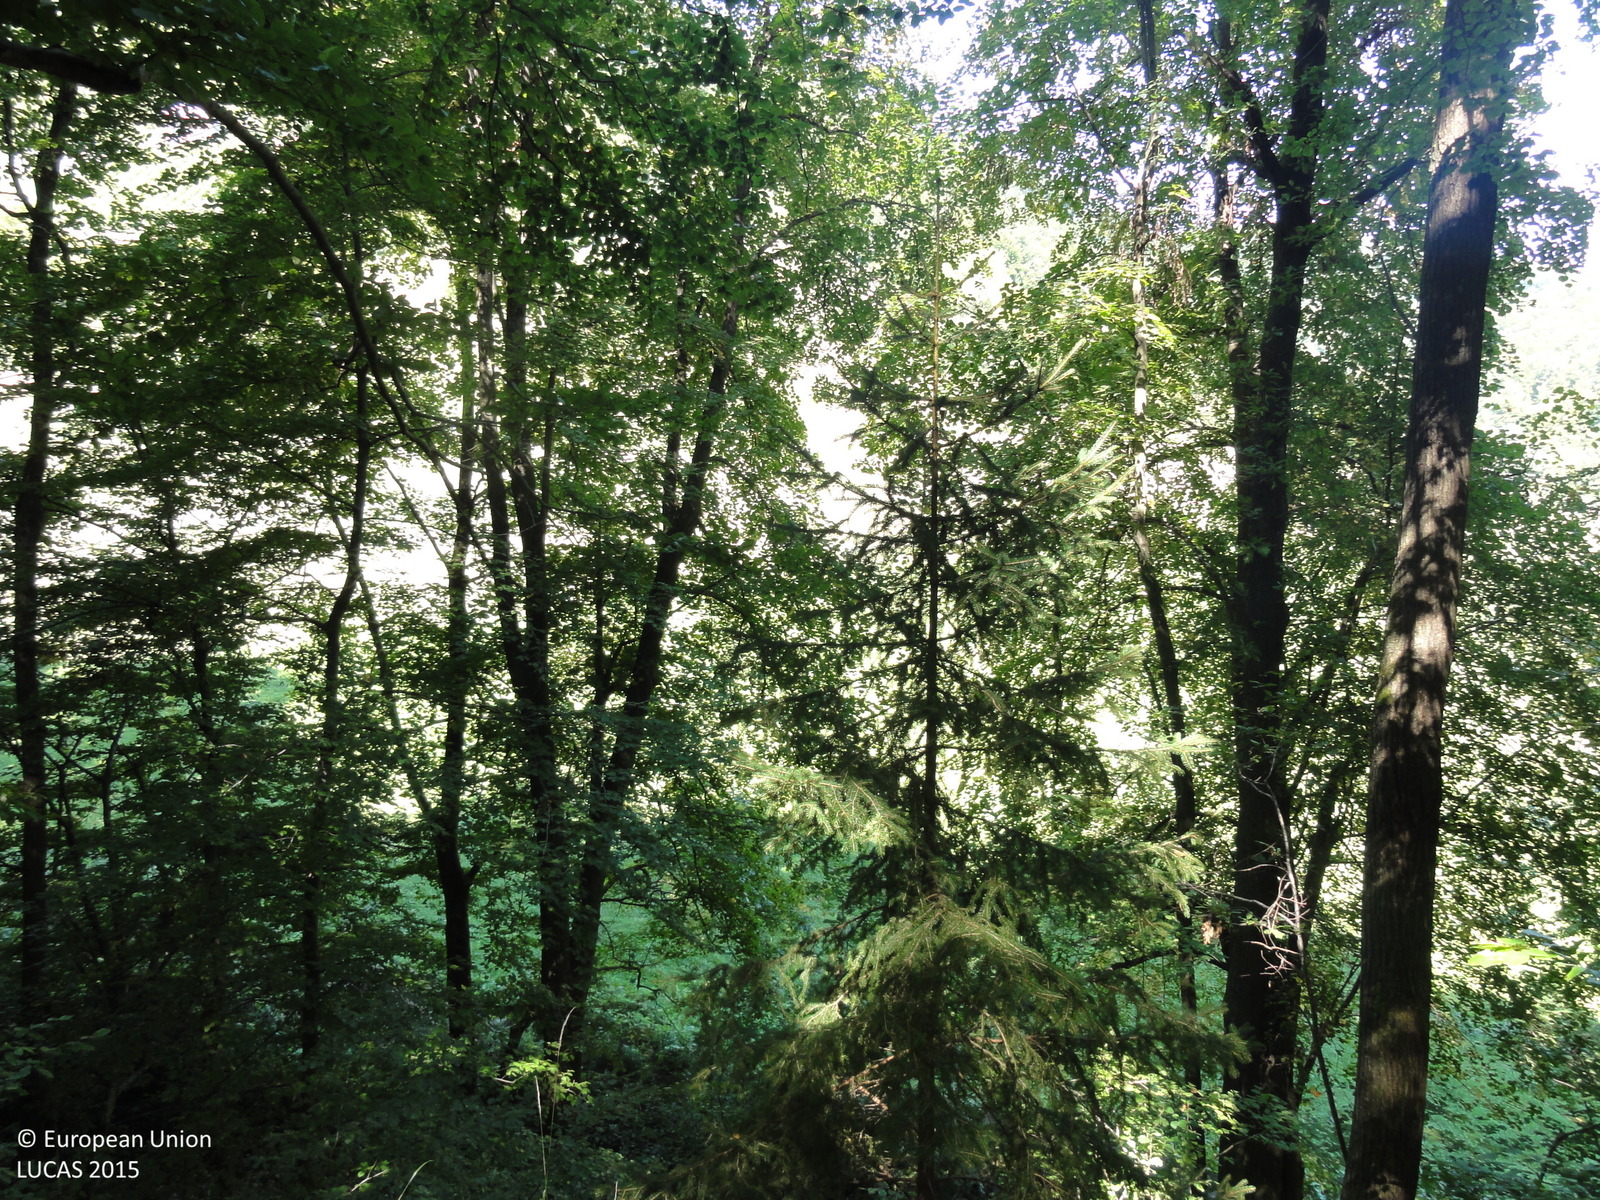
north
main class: Woodland
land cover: Broadleaved woodland
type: beech forest
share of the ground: > 75 %
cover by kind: broadleaved forest trees 95 %, coniferous forest trees 5 %
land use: Forestry
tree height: > 5 m
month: August
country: SI
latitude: 46.0118
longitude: 15.4864
